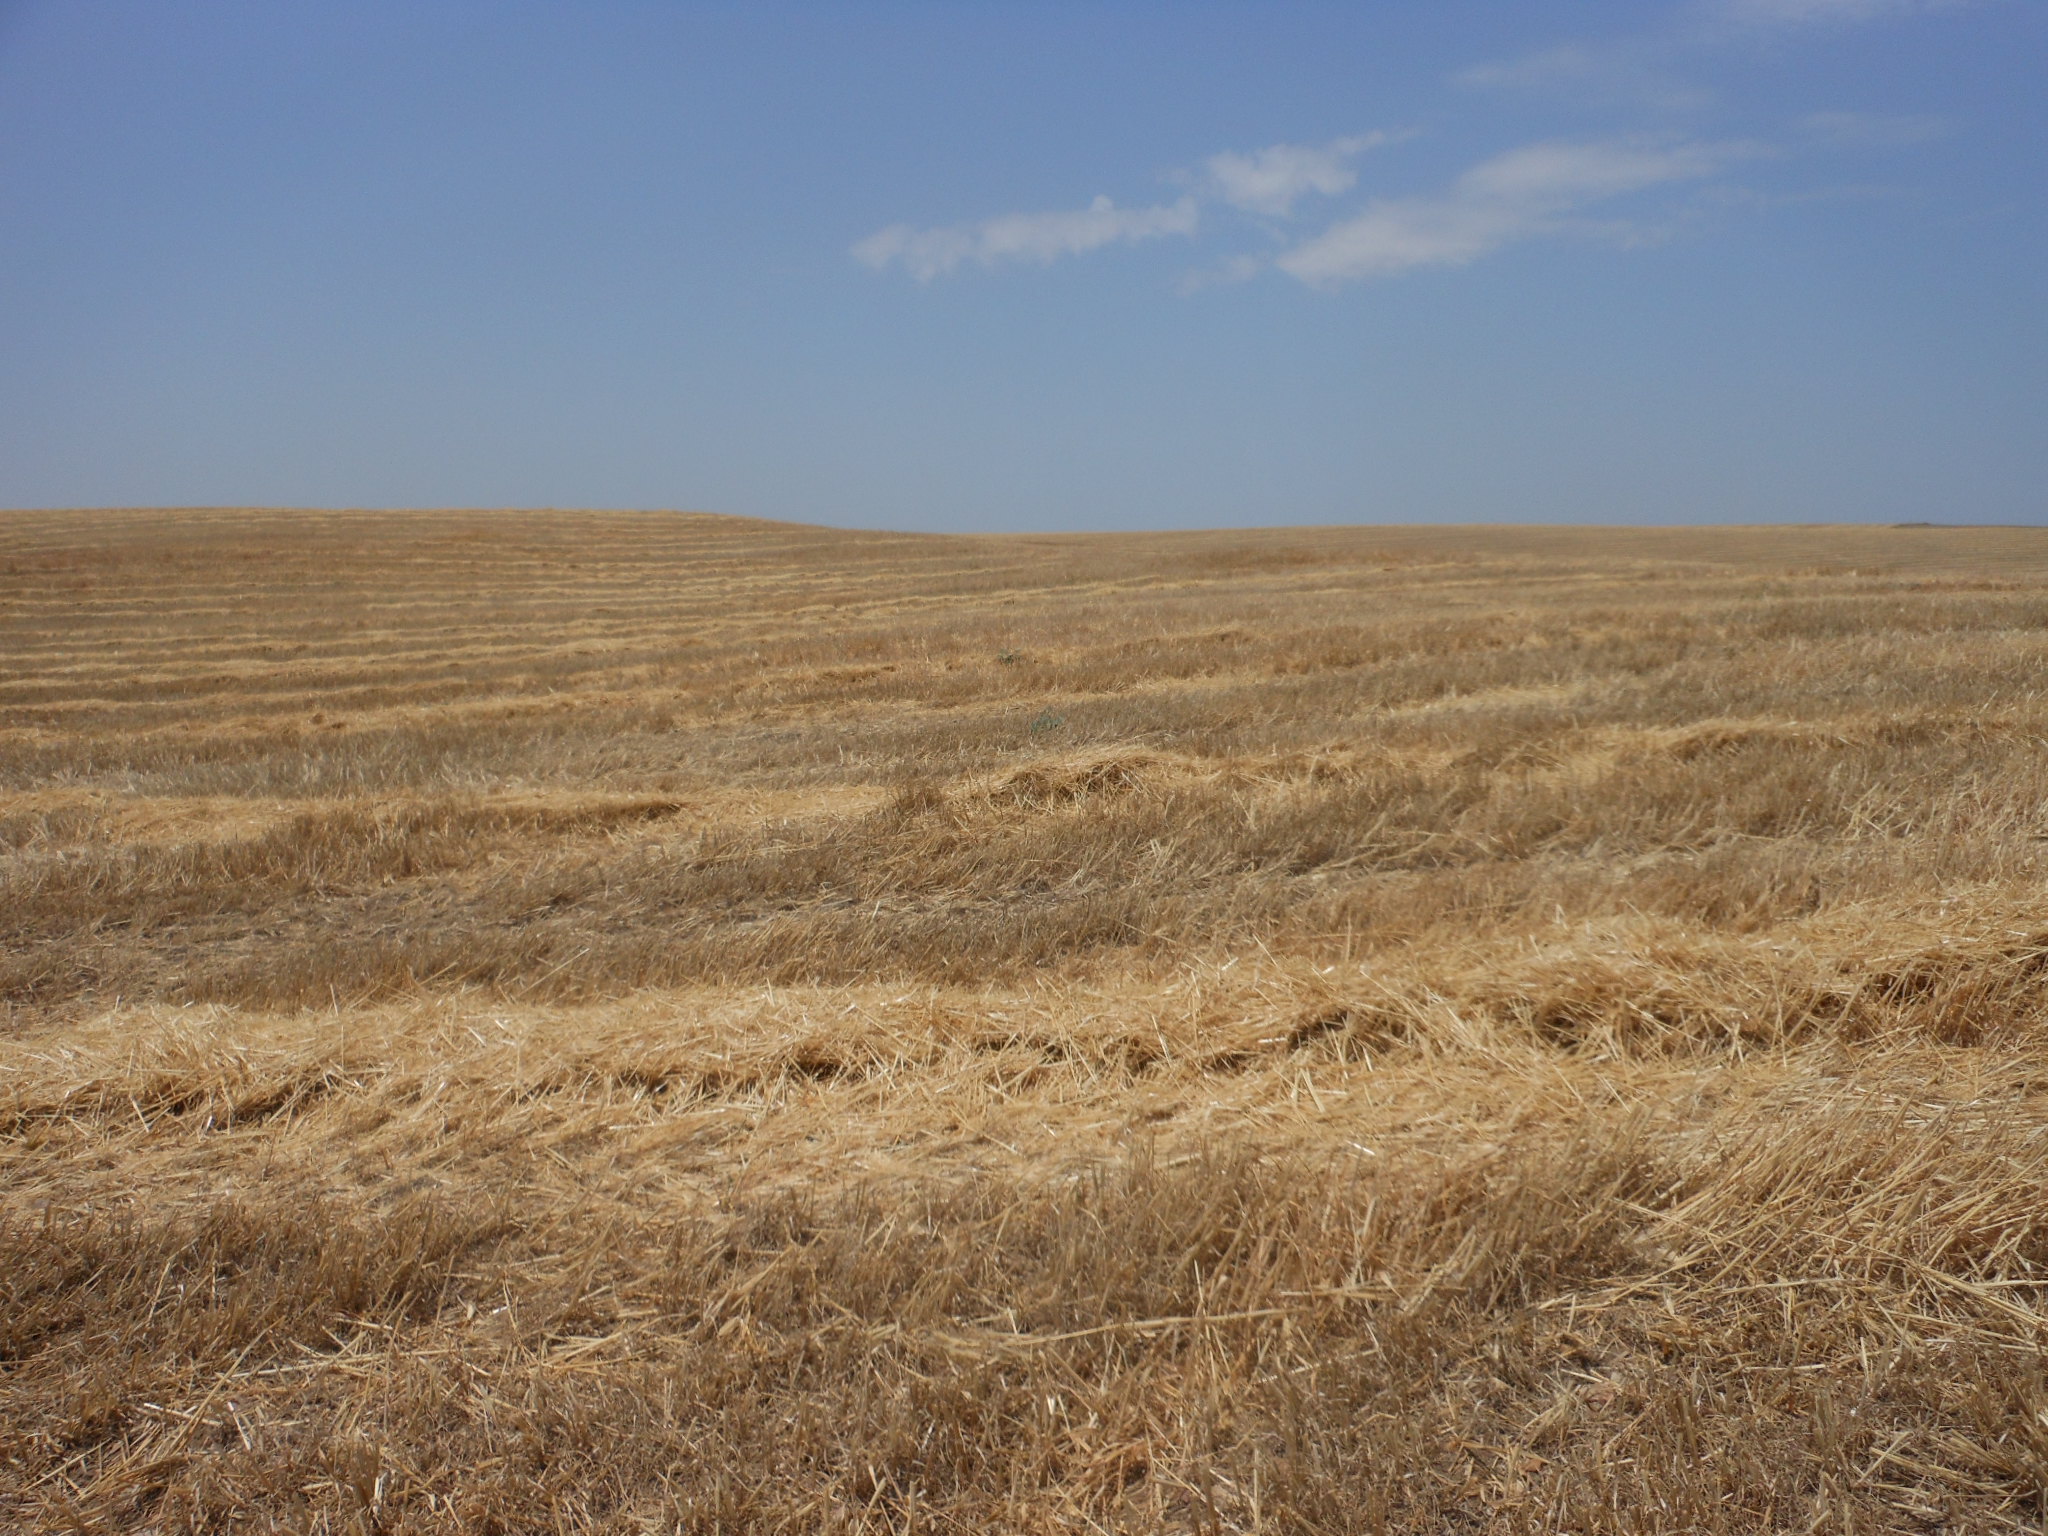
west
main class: Cropland
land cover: Durum wheat
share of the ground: < 10 %
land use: Agriculture (excluding fallow land and kitchen gardens)
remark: Harvested field
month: June
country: ES
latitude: 37.5110
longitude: -5.0927
